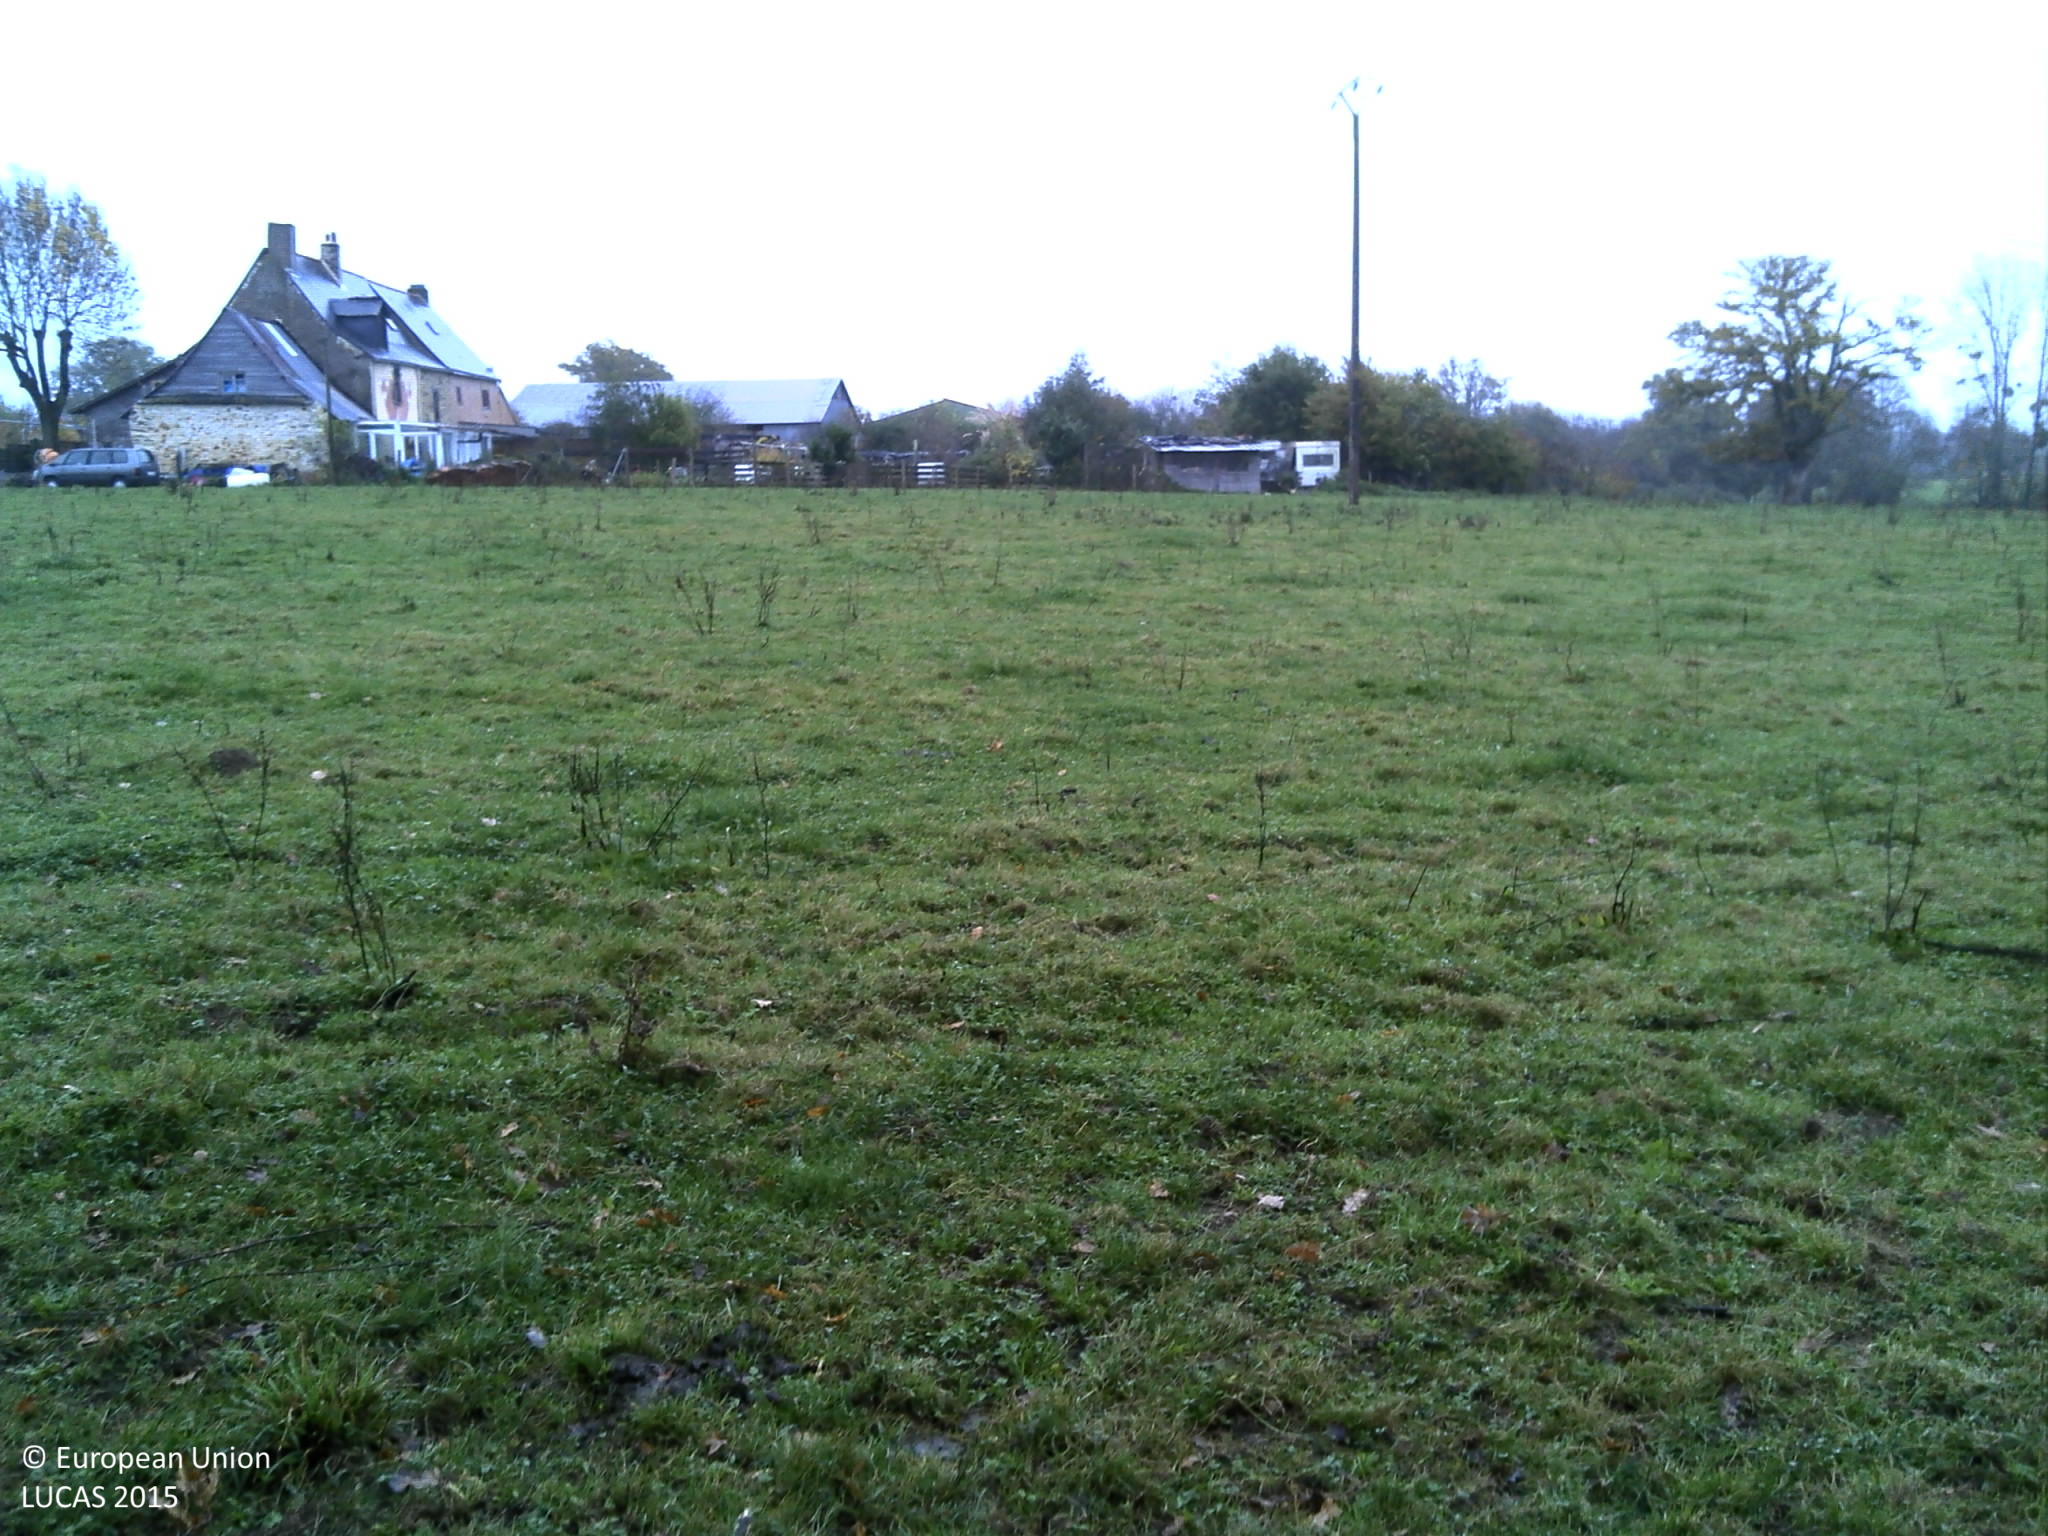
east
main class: Cropland
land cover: Temporary grasslands
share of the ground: > 75 %
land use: Agriculture (excluding fallow land and kitchen gardens)
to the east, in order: Temporary grasslands; Electric lines; Temporary grasslands; Fences; Ditches and canals; Fences; Single bushes/trees; Grassland without tree/shrub cover; Fences; Grassland without tree/shrub cover; Fences; Lines of trees; Fences; Grassland without tree/shrub cover
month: November
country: FR
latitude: 47.6168
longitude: -1.5256
